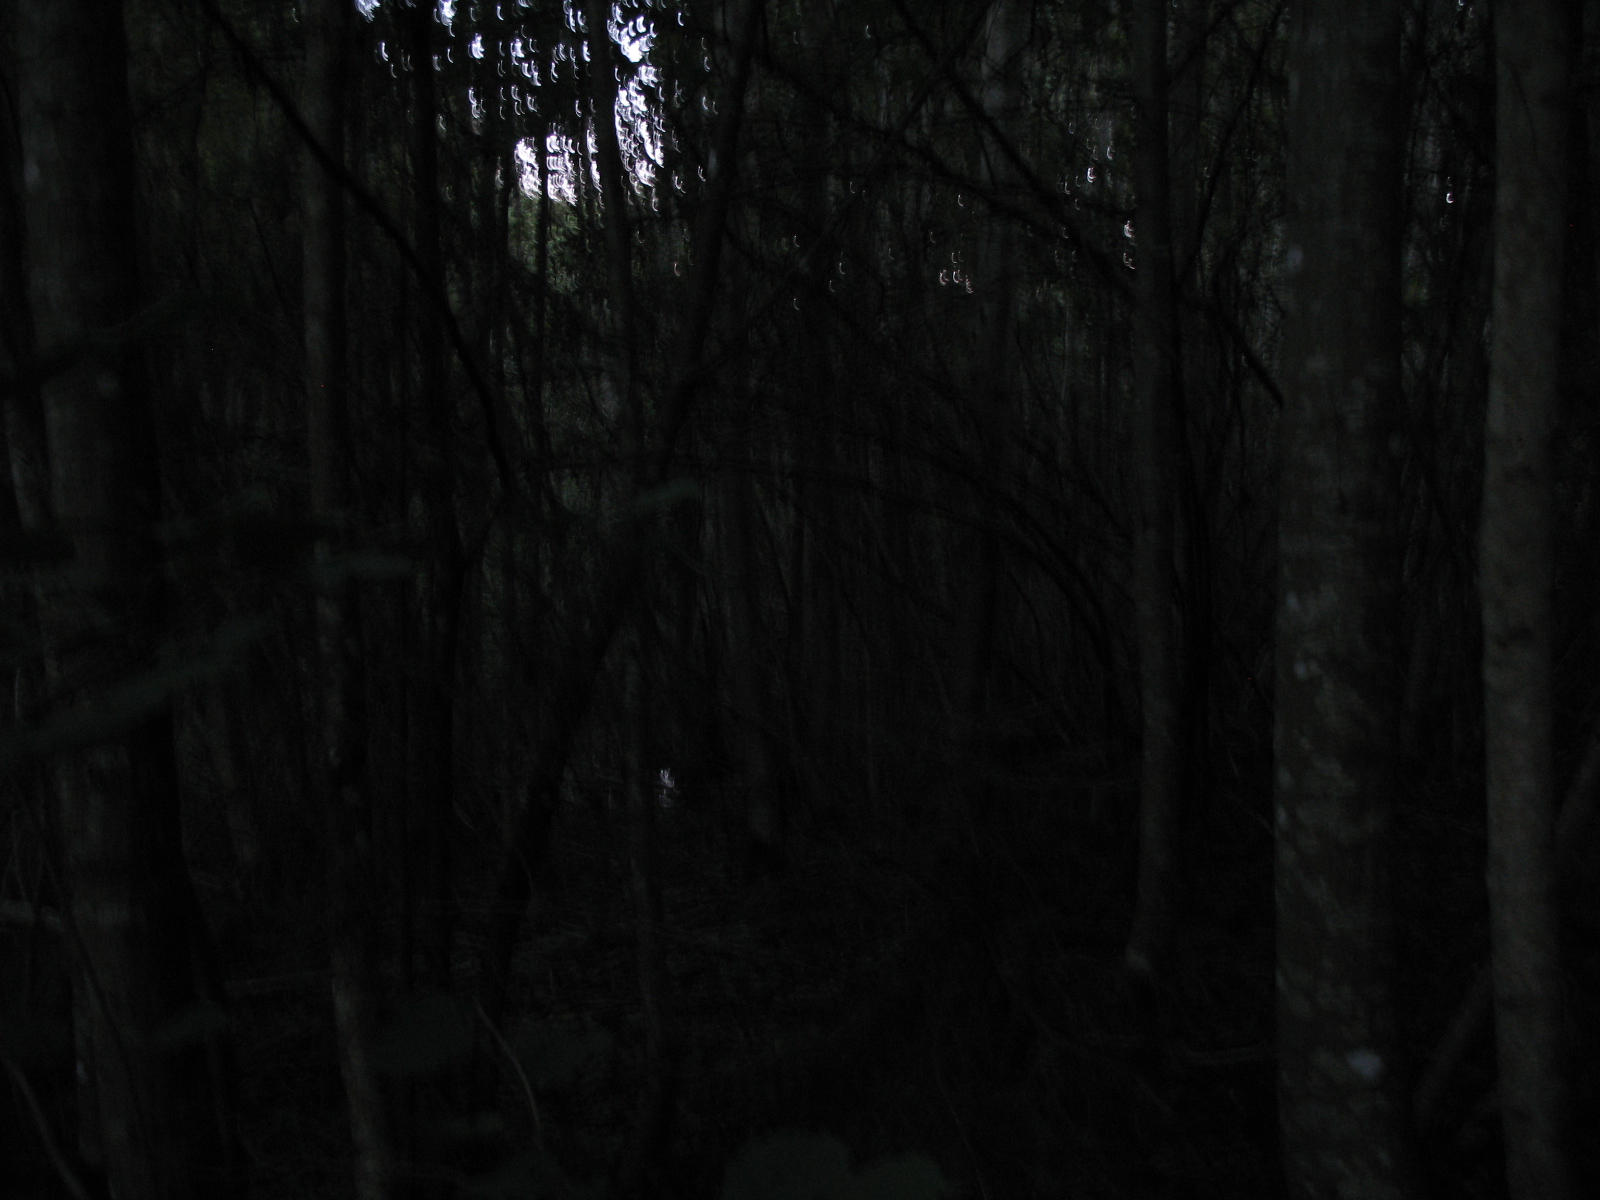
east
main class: Woodland
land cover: Broadleaved woodland
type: non-riverine alder, birch or aspen forest
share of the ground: > 75 %
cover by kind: broadleaved forest trees 90 %, unconsolidated bare surface 5 %
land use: Forestry
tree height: > 5 m
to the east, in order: Broadleaved woodland; Ditches and canals; Broadleaved woodland; Spruce dominated mixed woodland; Broadleaved woodland; Tracks; Spontaneously vegetated surfaces; Broadleaved woodland; Ditches and canals; Broadleaved woodland; Spontaneously vegetated surfaces; Broadleaved woodland
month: August
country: LV
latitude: 56.4702
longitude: 25.6257
